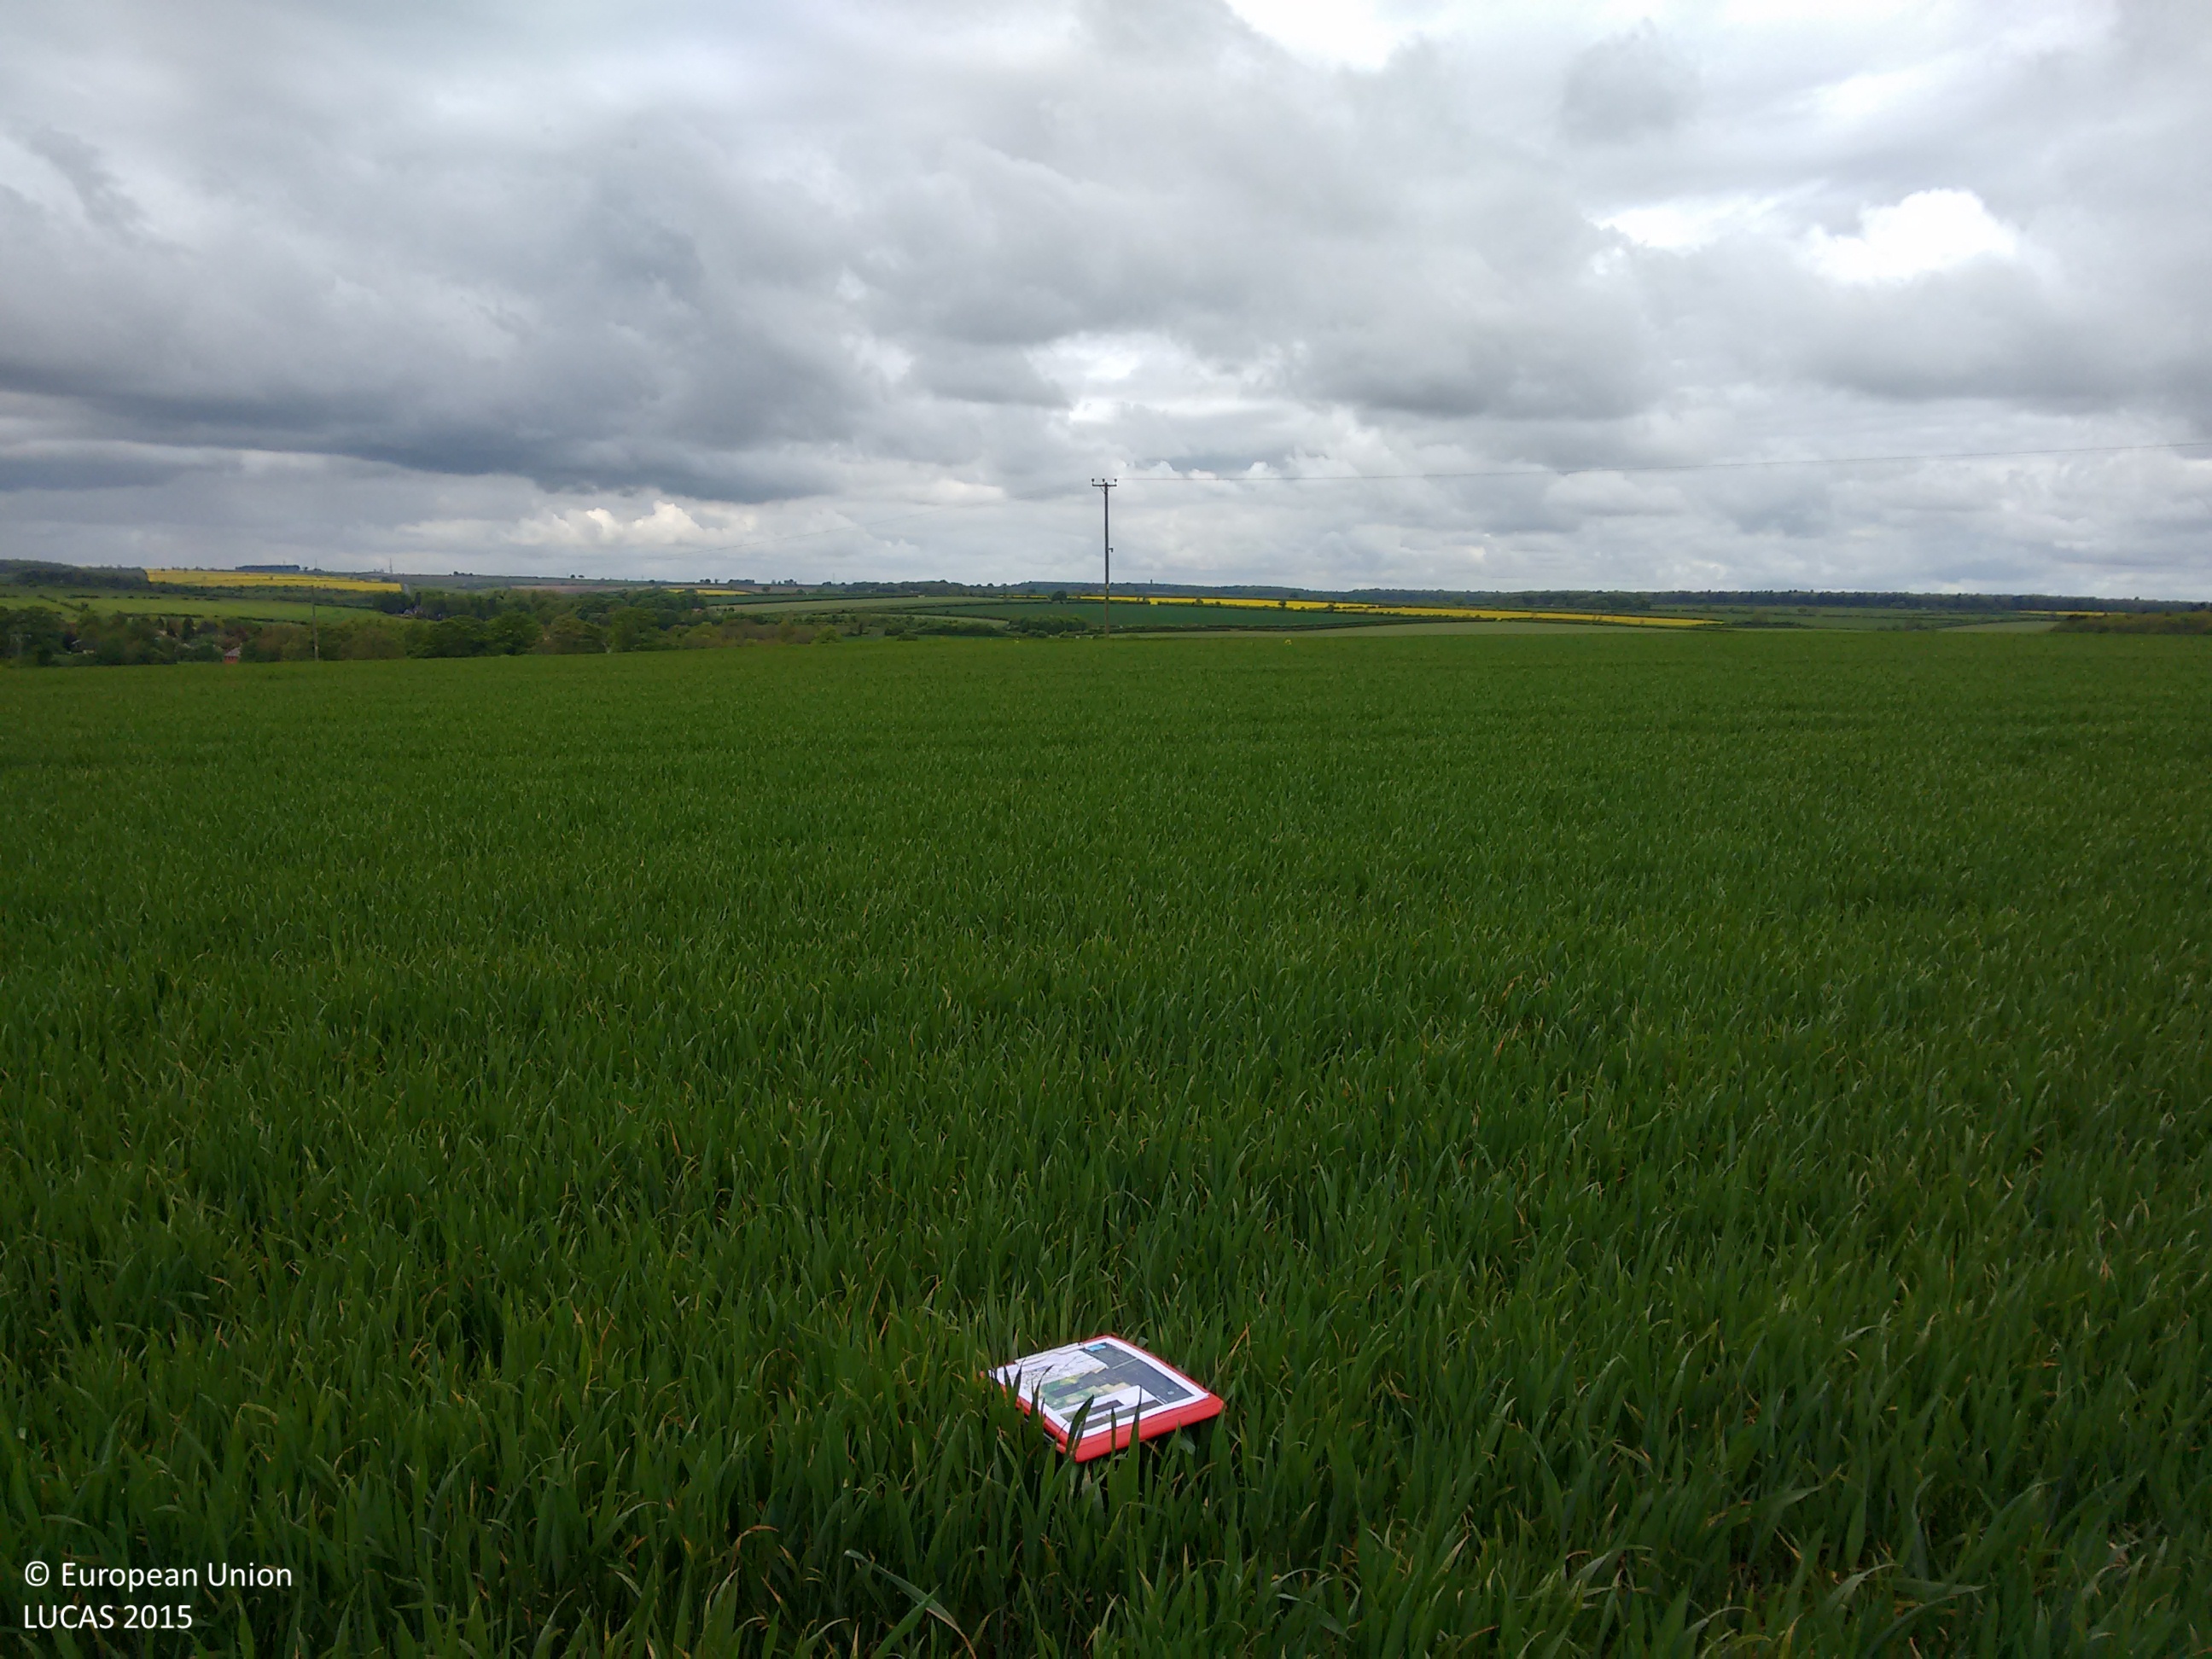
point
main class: Cropland
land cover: Common wheat
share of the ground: > 75 %
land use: Agriculture (excluding fallow land and kitchen gardens)
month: May
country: GB
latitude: 53.5128
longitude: -0.2130
